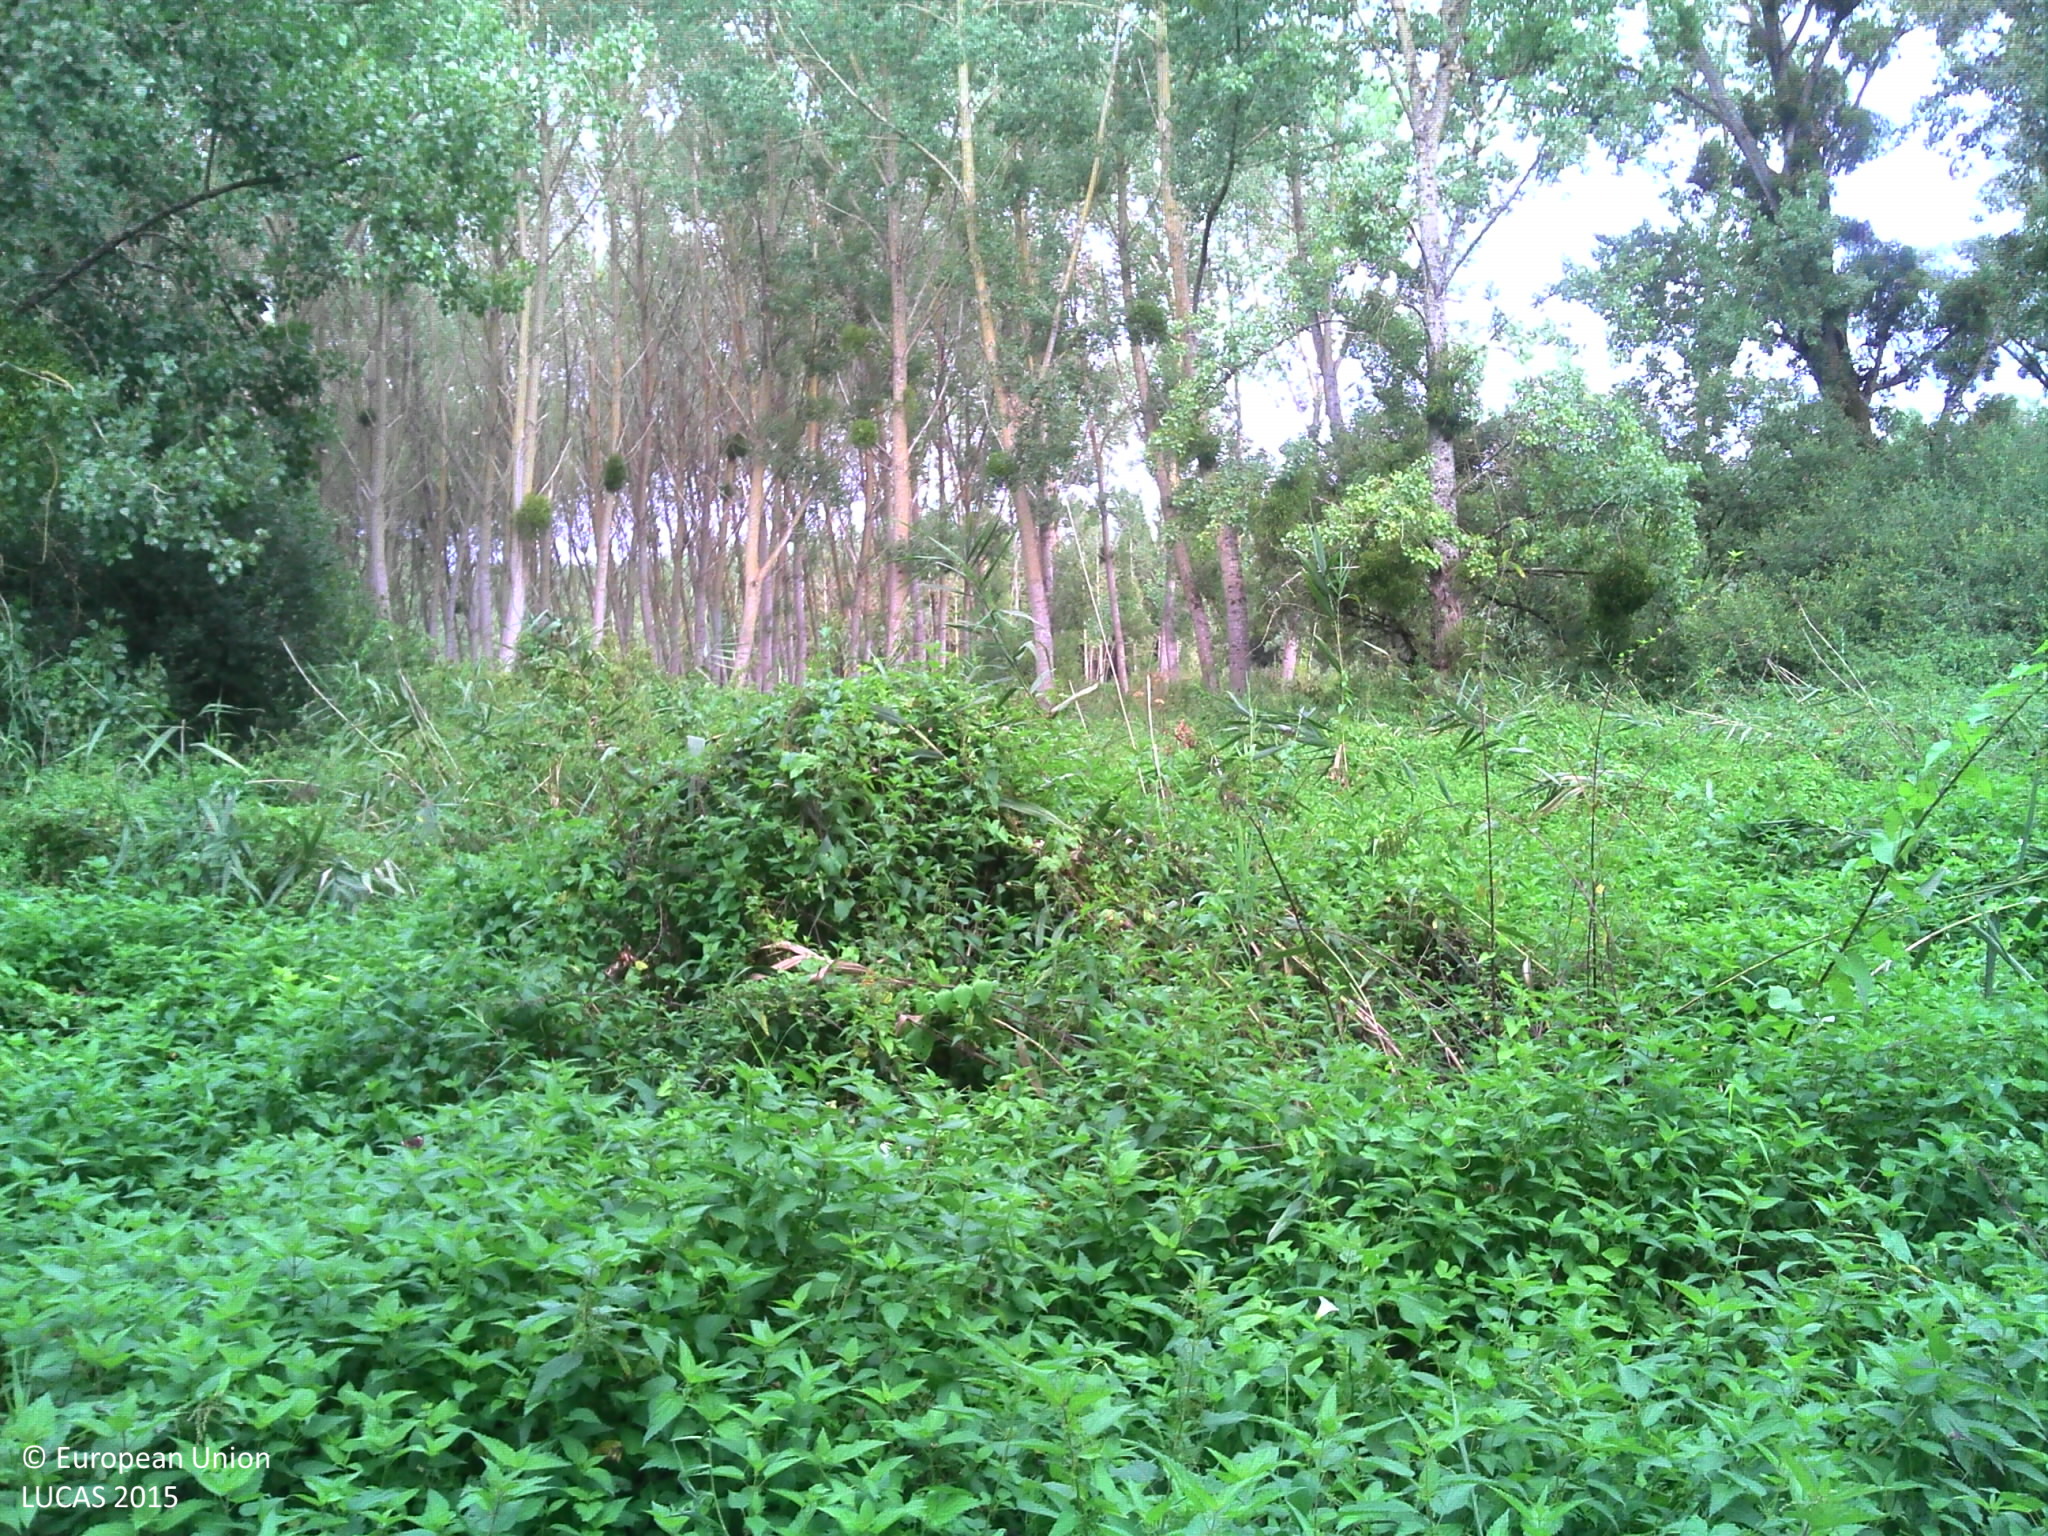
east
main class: Grassland
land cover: Spontaneously vegetated surfaces
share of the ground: > 75 %
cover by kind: herbaceous plants 100 %
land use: Semi-natural and natural areas not in use
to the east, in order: Spontaneously vegetated surfaces; Broadleaved woodland; Spontaneously vegetated surfaces
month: September
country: FR
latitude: 46.8593
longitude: 1.4490
